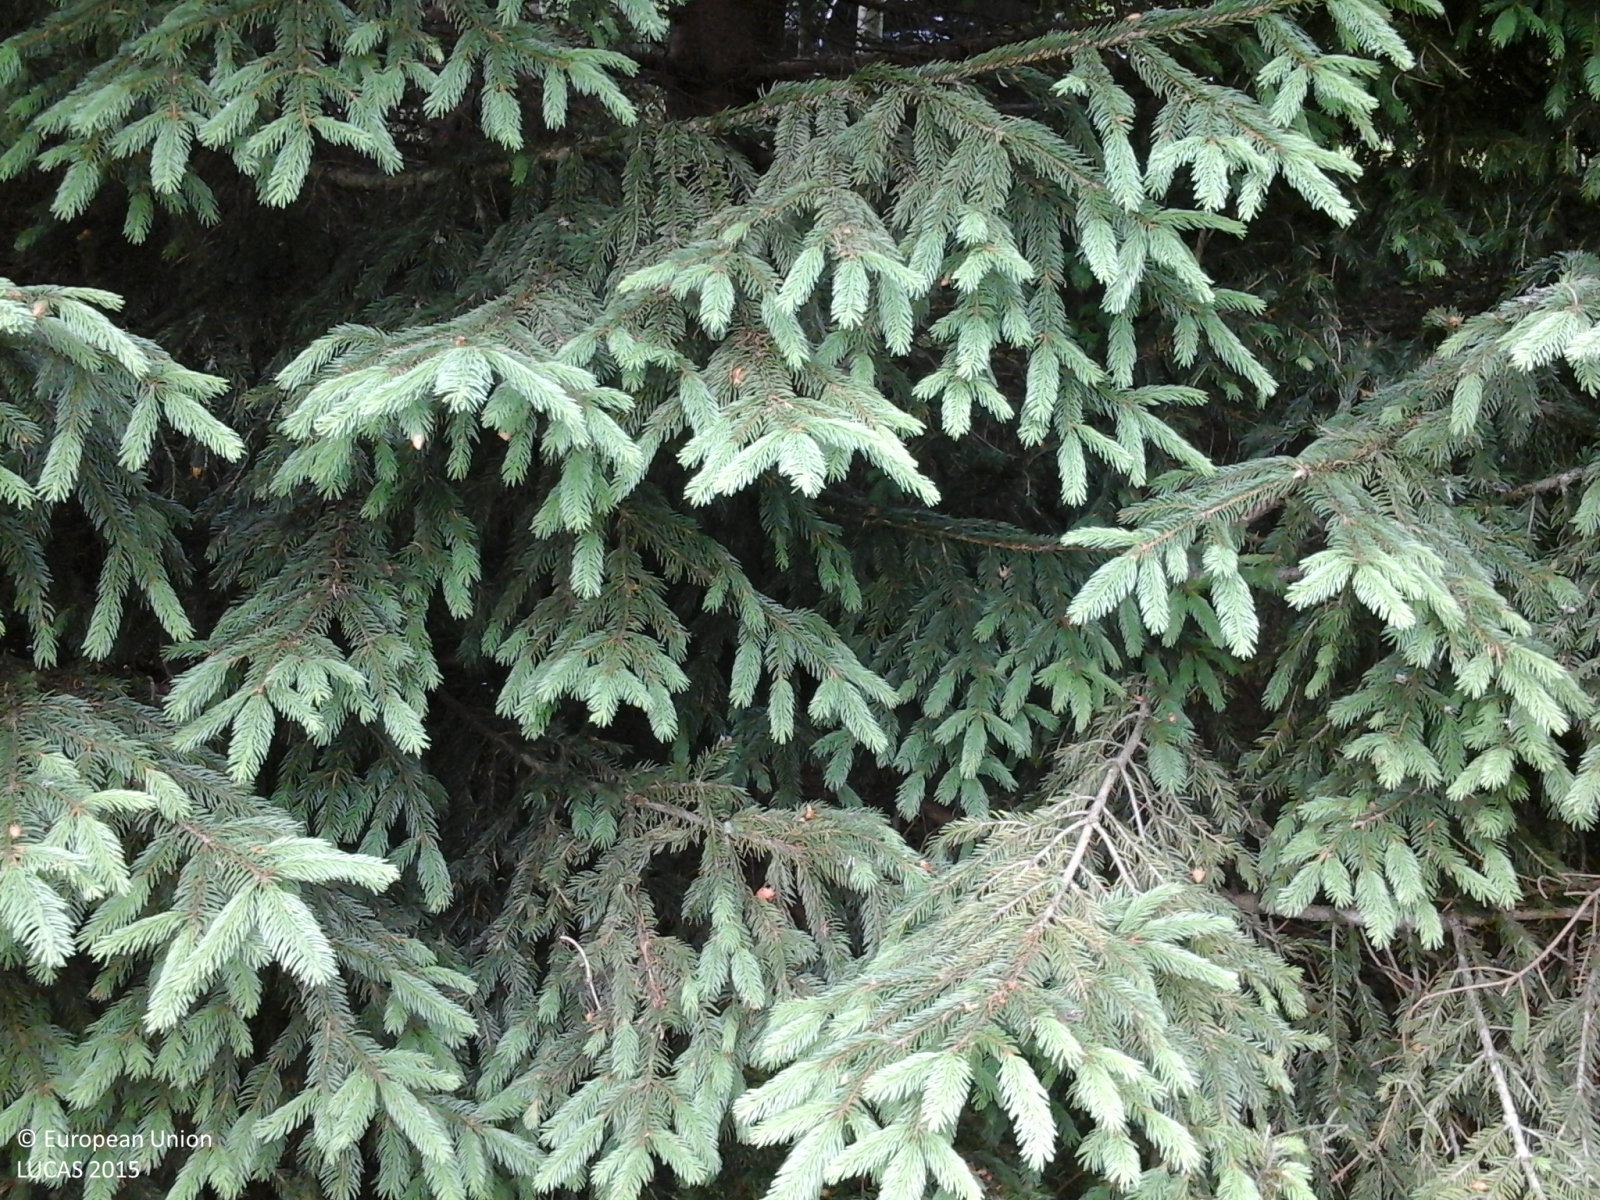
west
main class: Grassland
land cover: Grassland with sparse tree/shrub cover
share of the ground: > 75 %
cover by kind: herbaceous plants 85 %, shrubs 10 %, coniferous forest trees 5 %
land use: Residential
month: June
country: IT
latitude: 46.1280
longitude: 12.3138
